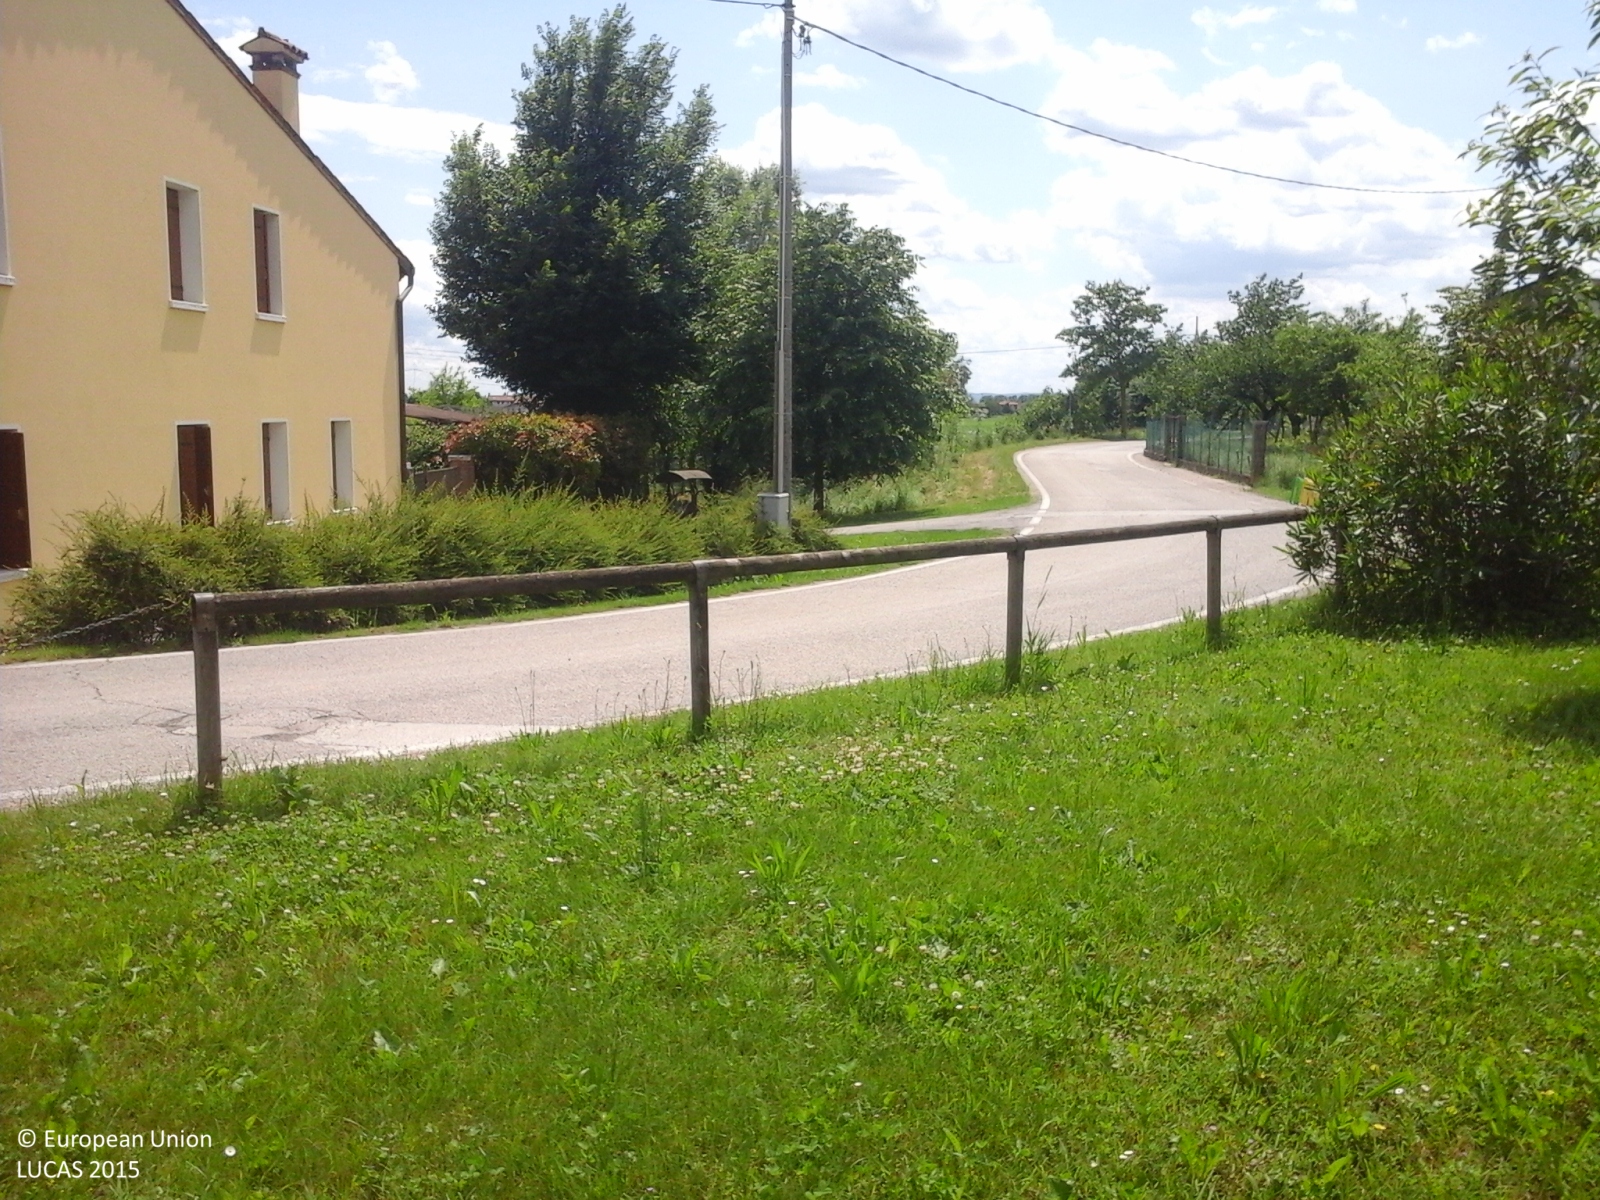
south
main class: Cropland
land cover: Other fresh vegetables
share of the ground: > 75 %
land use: Agriculture (excluding fallow land and kitchen gardens)
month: May
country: IT
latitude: 45.7077
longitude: 11.6545
